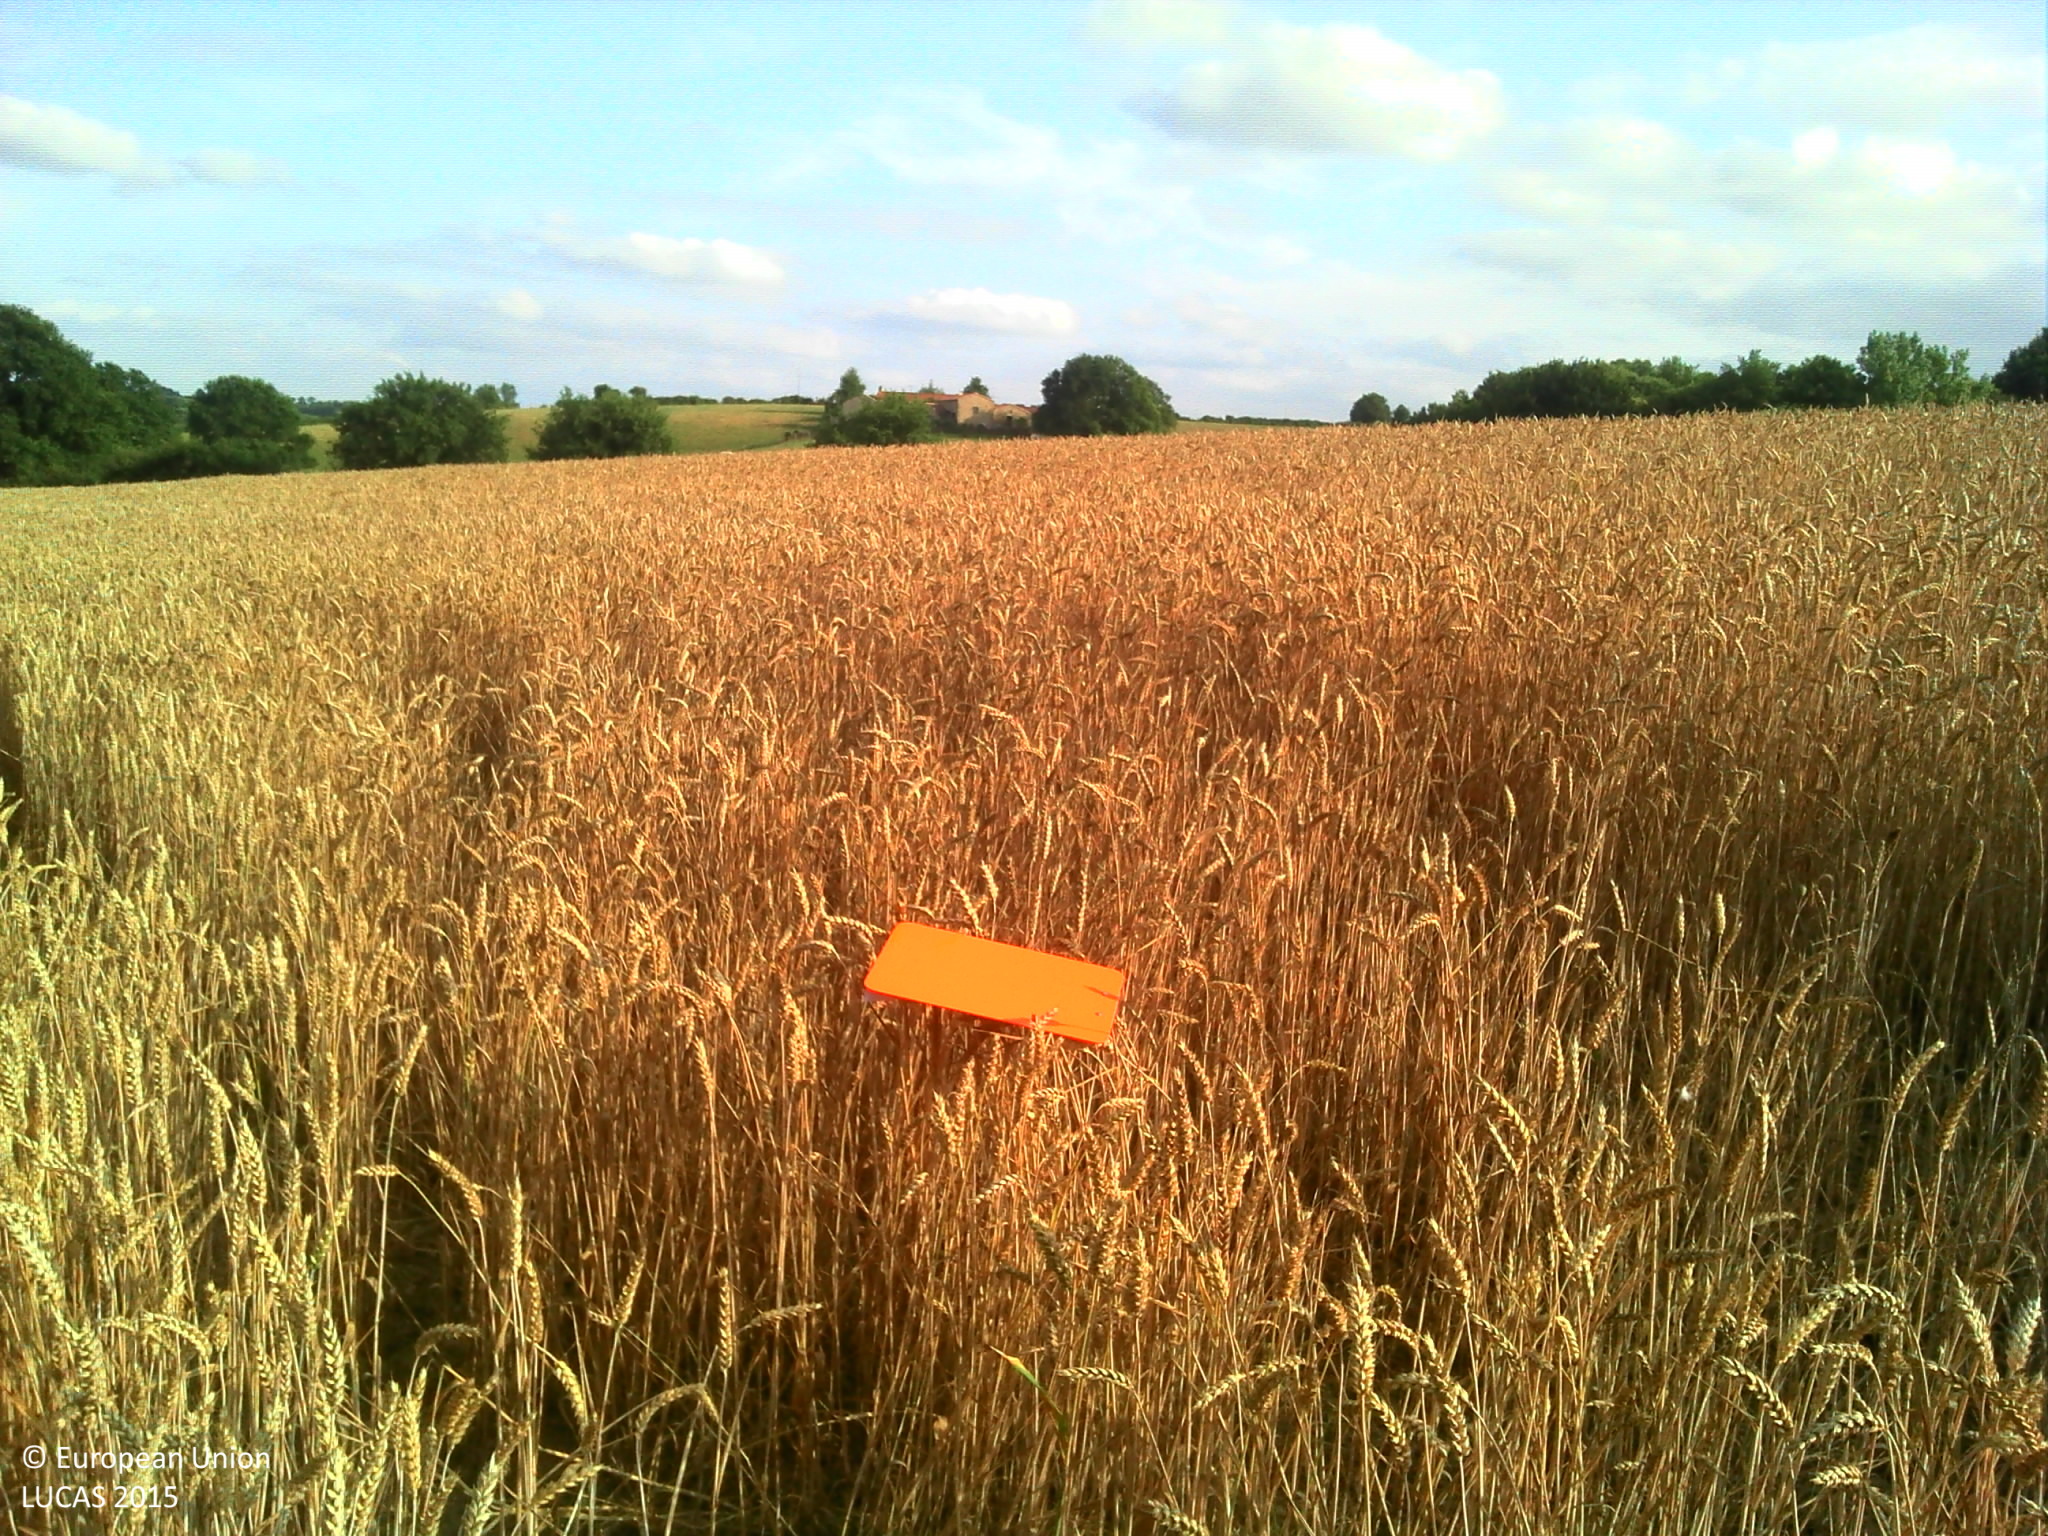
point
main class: Cropland
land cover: Common wheat
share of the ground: > 75 %
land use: Agriculture (excluding fallow land and kitchen gardens)
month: July
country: FR
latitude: 46.9319
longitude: -0.9482
